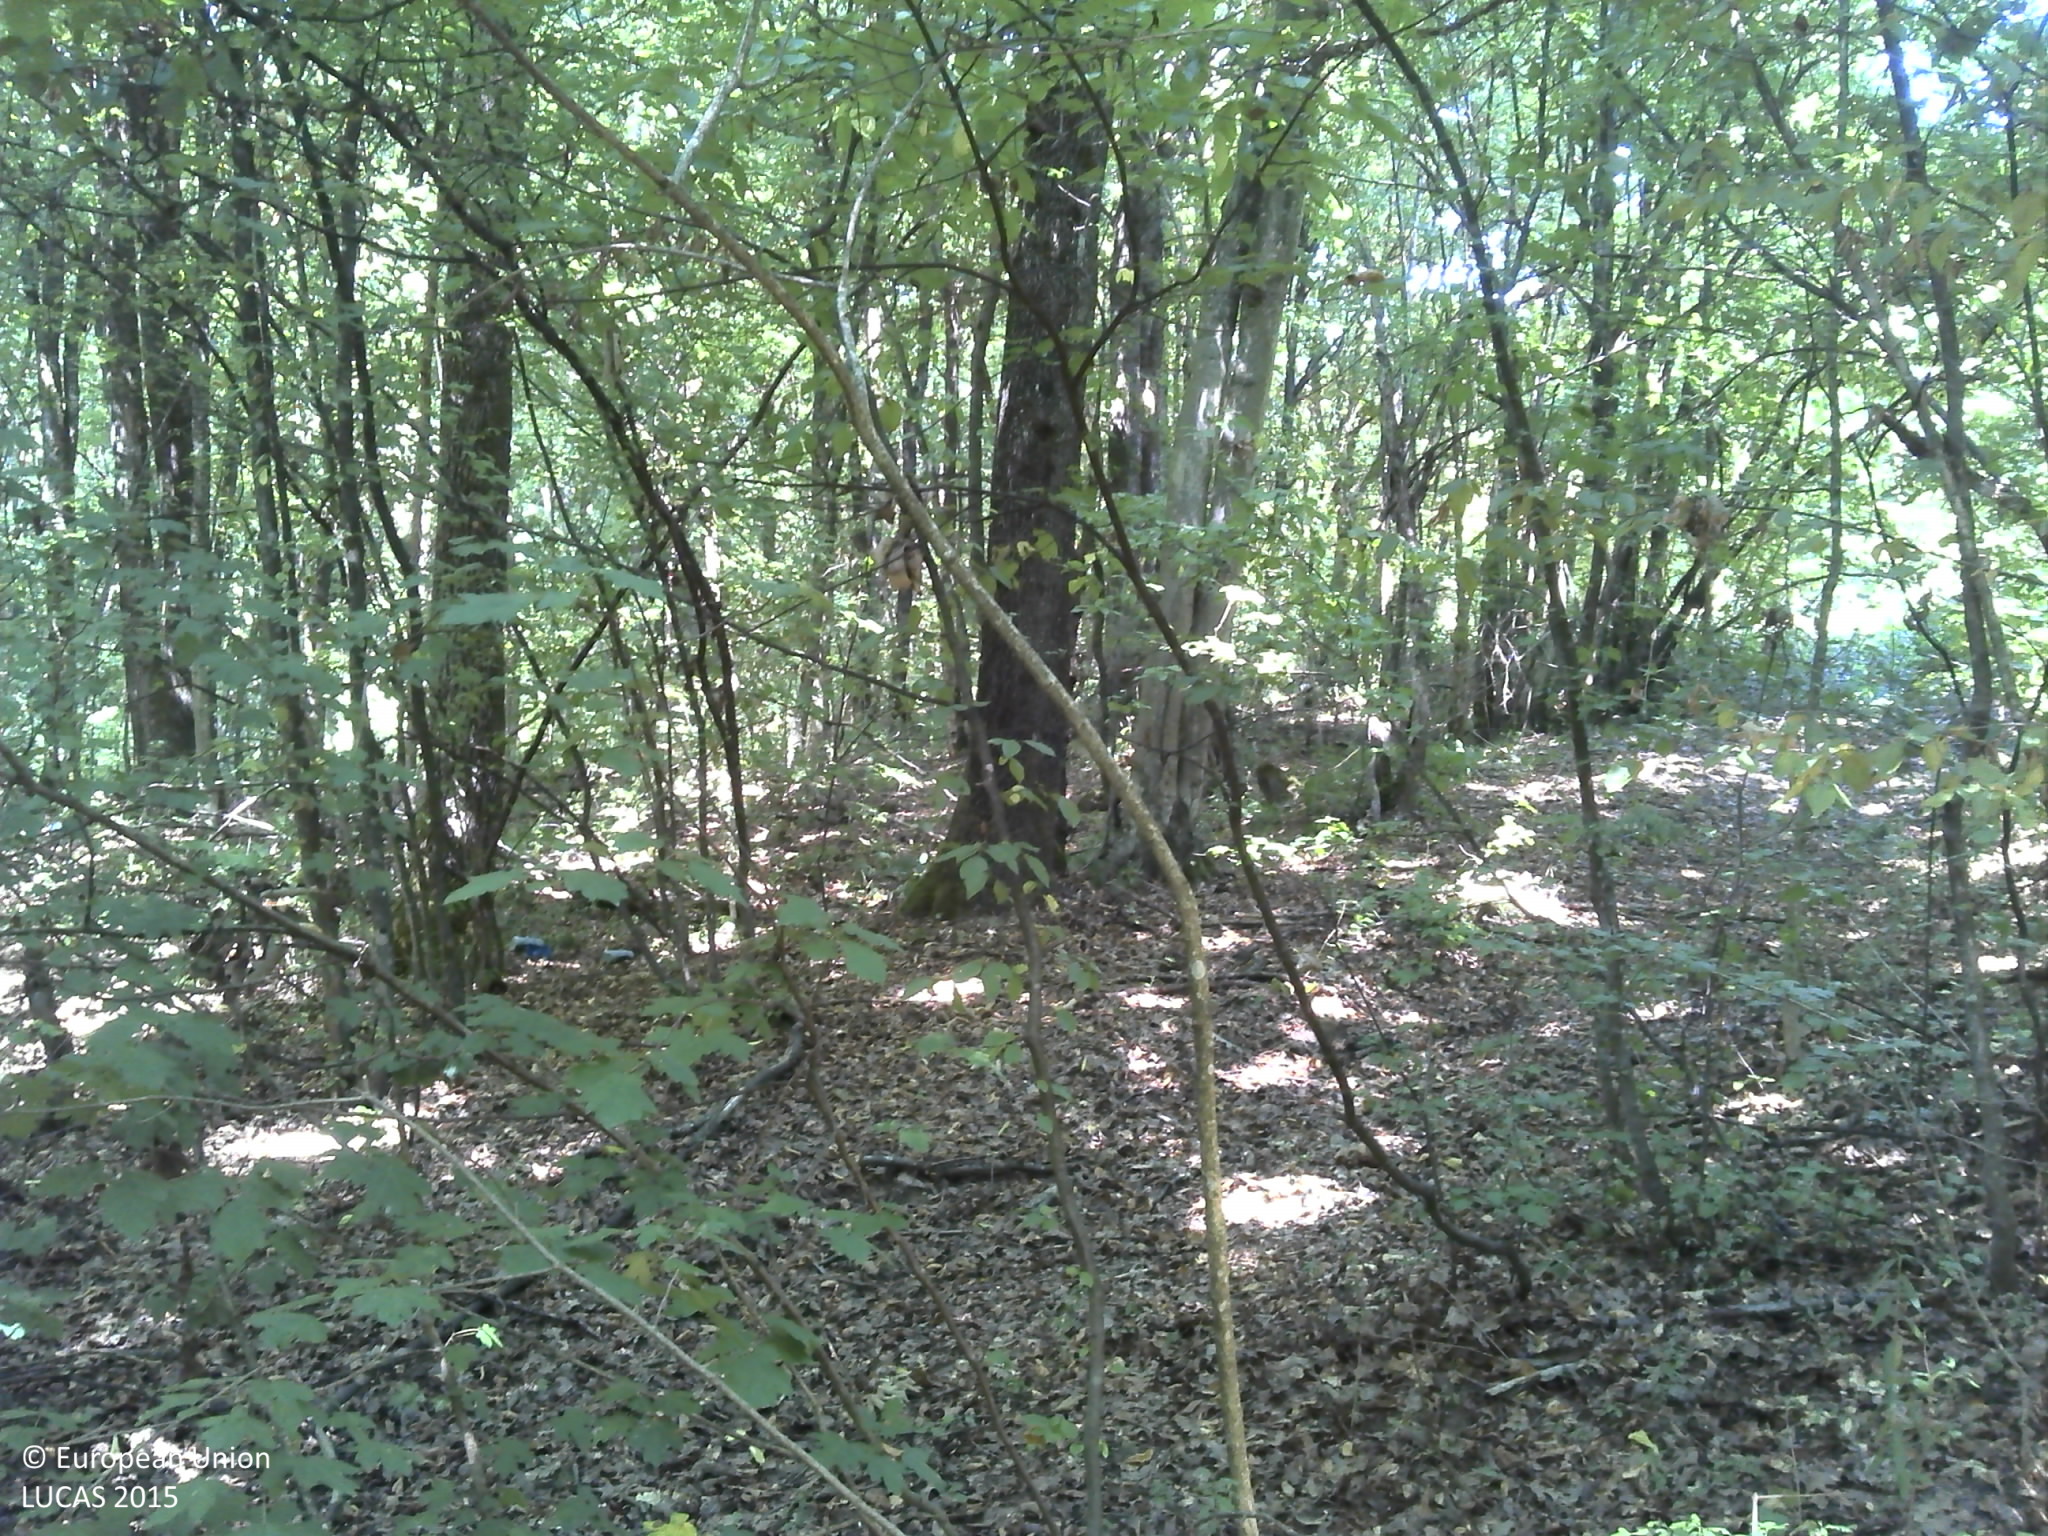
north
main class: Woodland
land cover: Broadleaved woodland
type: acidophilous oak and oak-birch forest
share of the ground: > 75 %
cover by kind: broadleaved forest trees 100 %
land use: Forestry
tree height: > 5 m
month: August
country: HR
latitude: 45.3601
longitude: 16.4701
